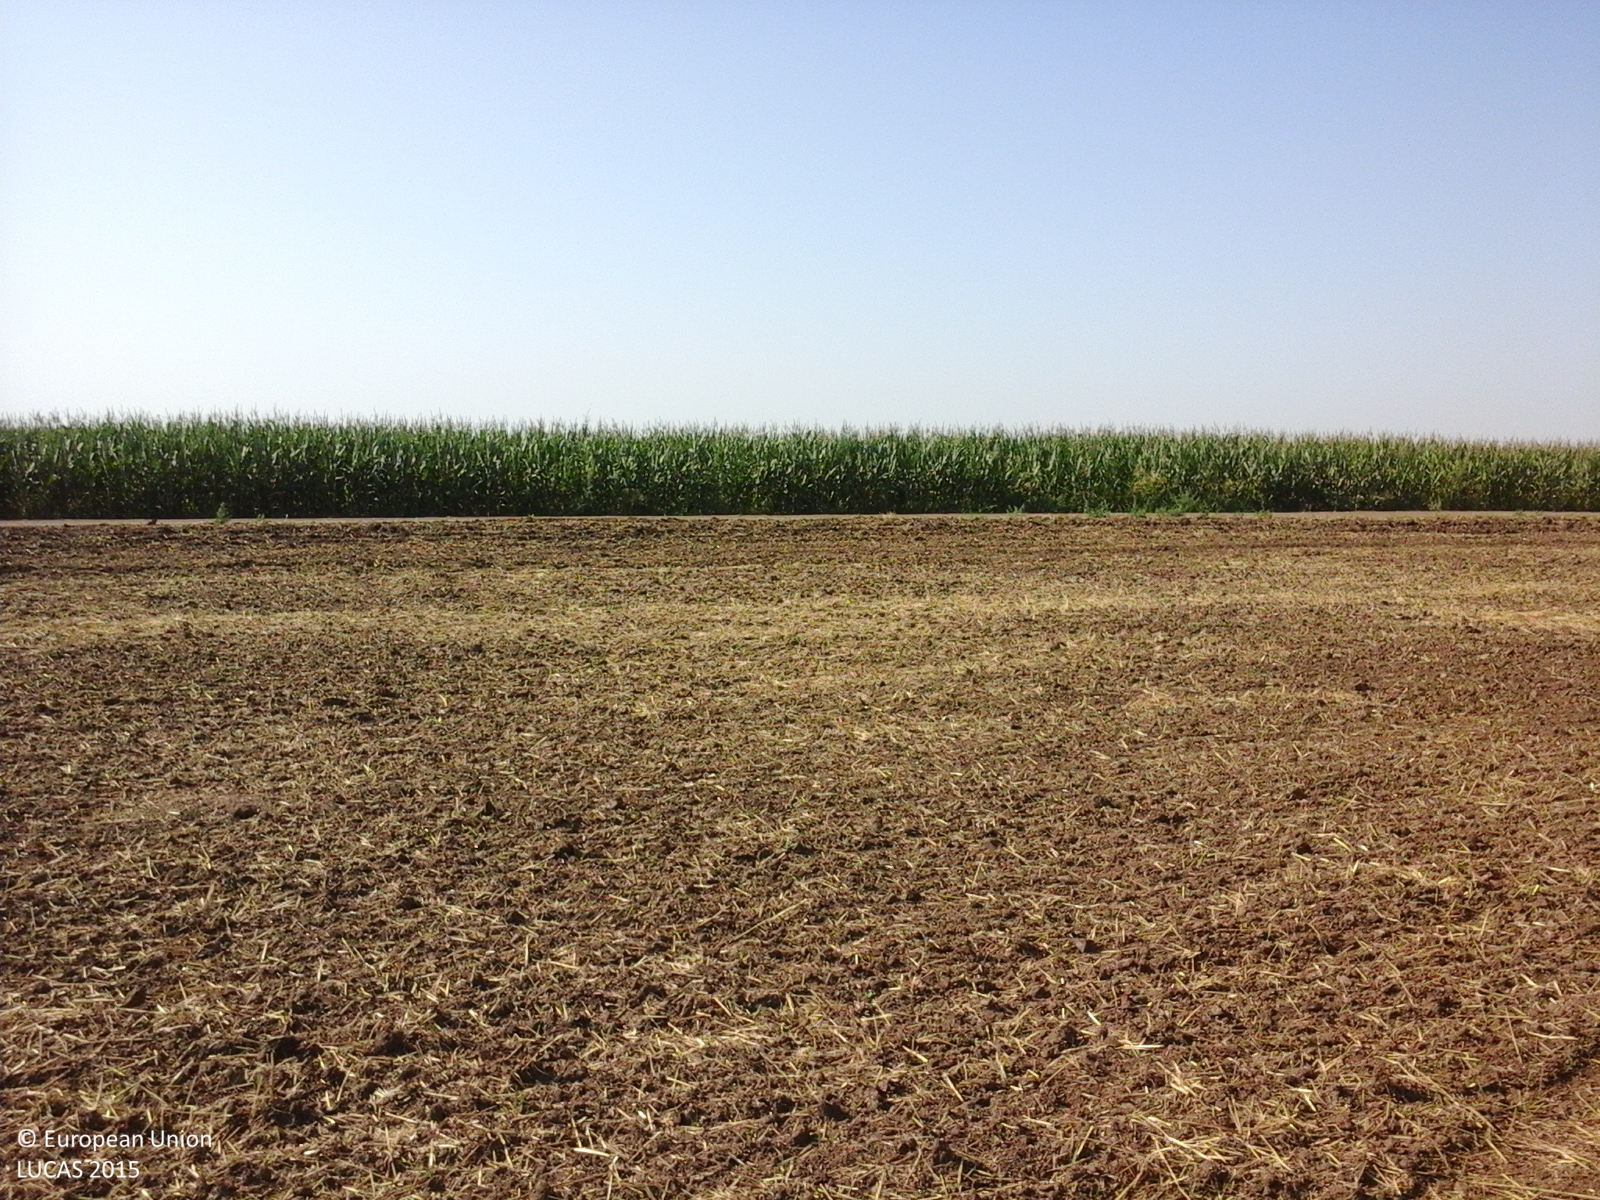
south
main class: Cropland
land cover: Durum wheat
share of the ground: < 10 %
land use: Agriculture (excluding fallow land and kitchen gardens)
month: July
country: RO
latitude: 44.3567
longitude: 27.5184
